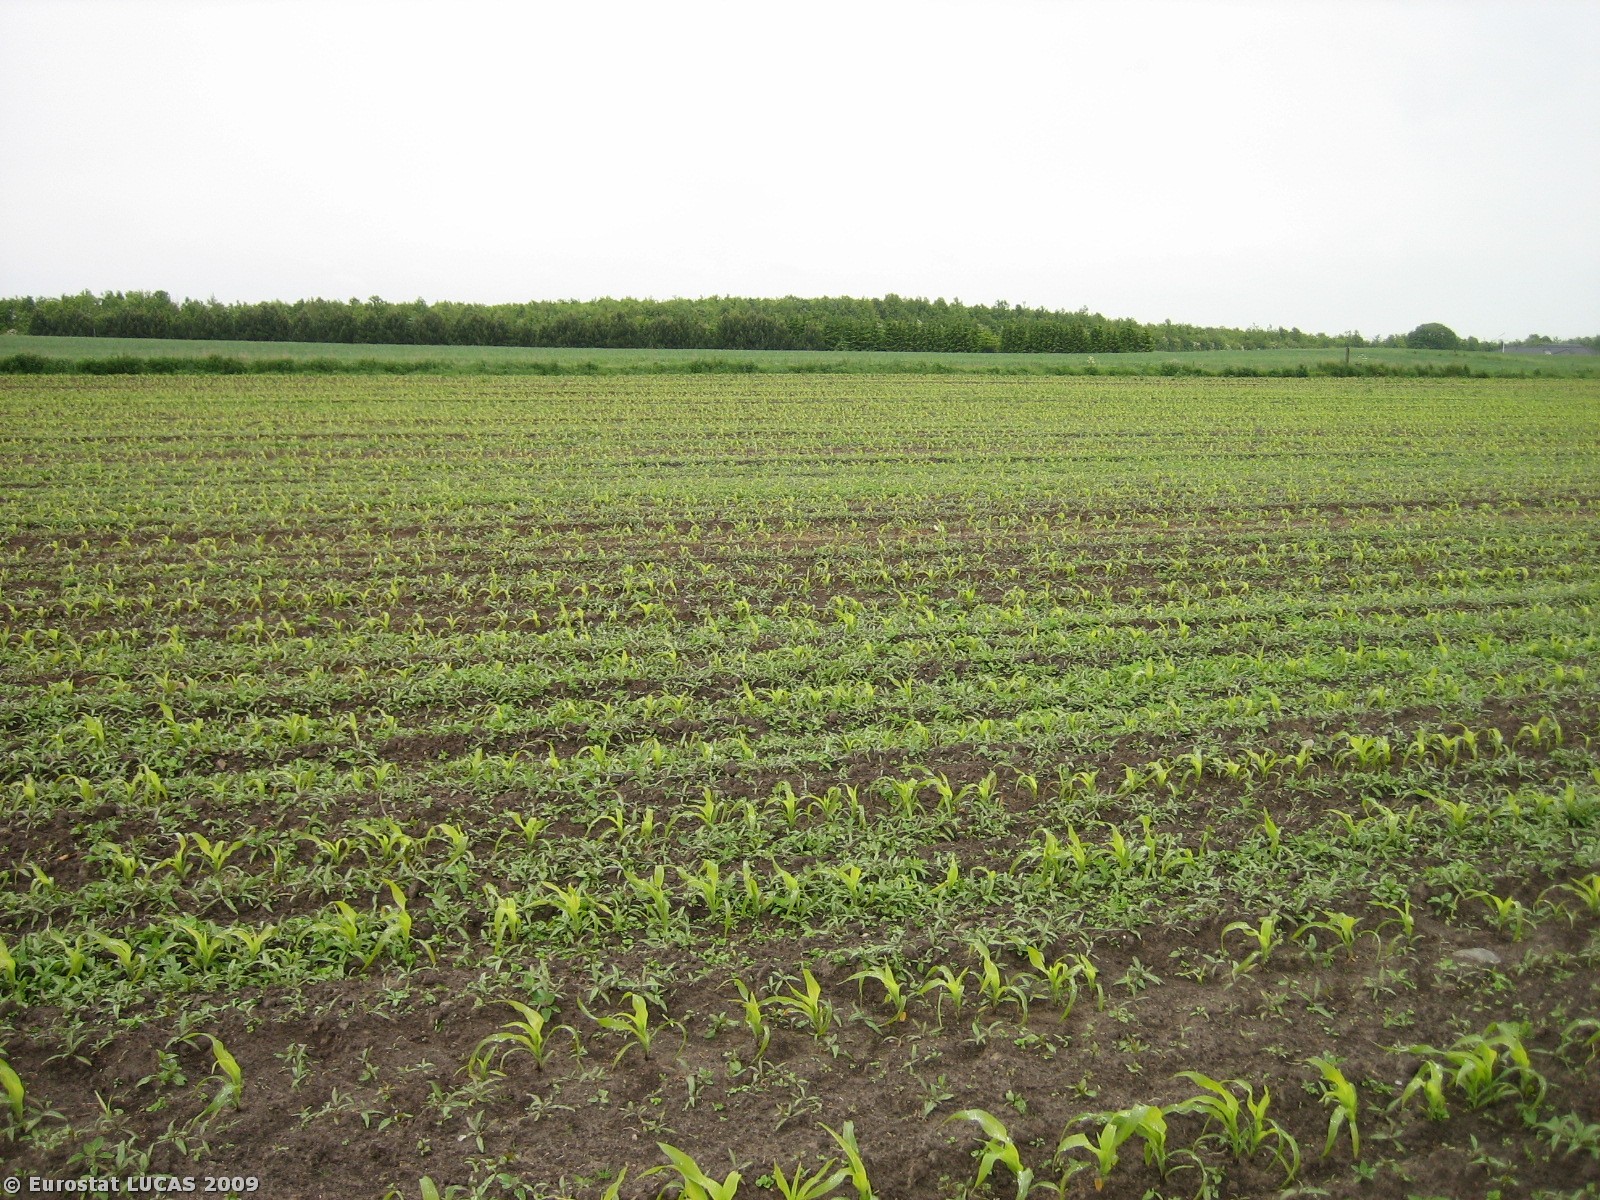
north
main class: Cropland
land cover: Maize
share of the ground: < 10 %
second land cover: Spontaneously vegetated surfaces
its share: 10 - 25 %
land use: Agriculture (excluding fallow land and kitchen gardens)
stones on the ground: < 10 %
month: June
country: DK
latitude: 56.2416
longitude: 10.1128
